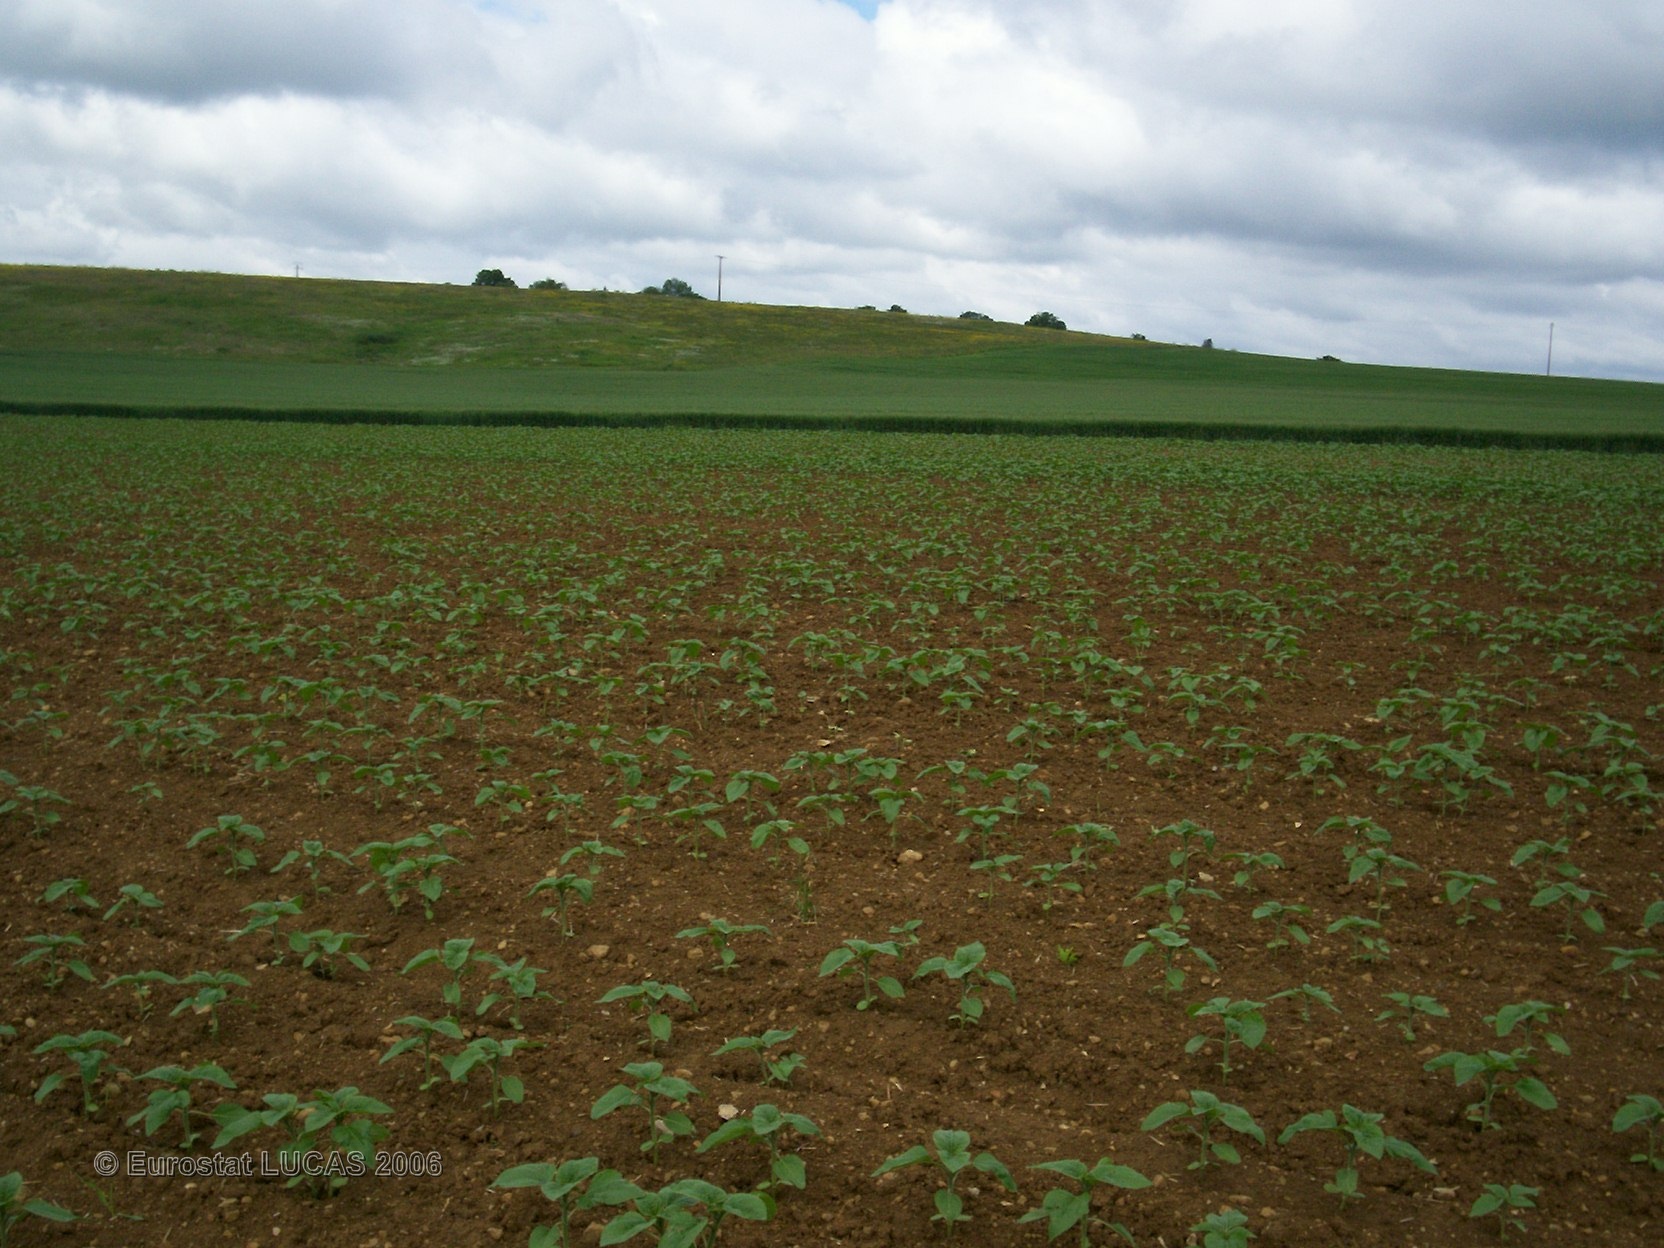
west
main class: Cropland
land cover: Sunflower
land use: Agriculture (excluding fallow land and kitchen gardens)
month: May
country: FR
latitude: 48.2687
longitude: 4.5413
